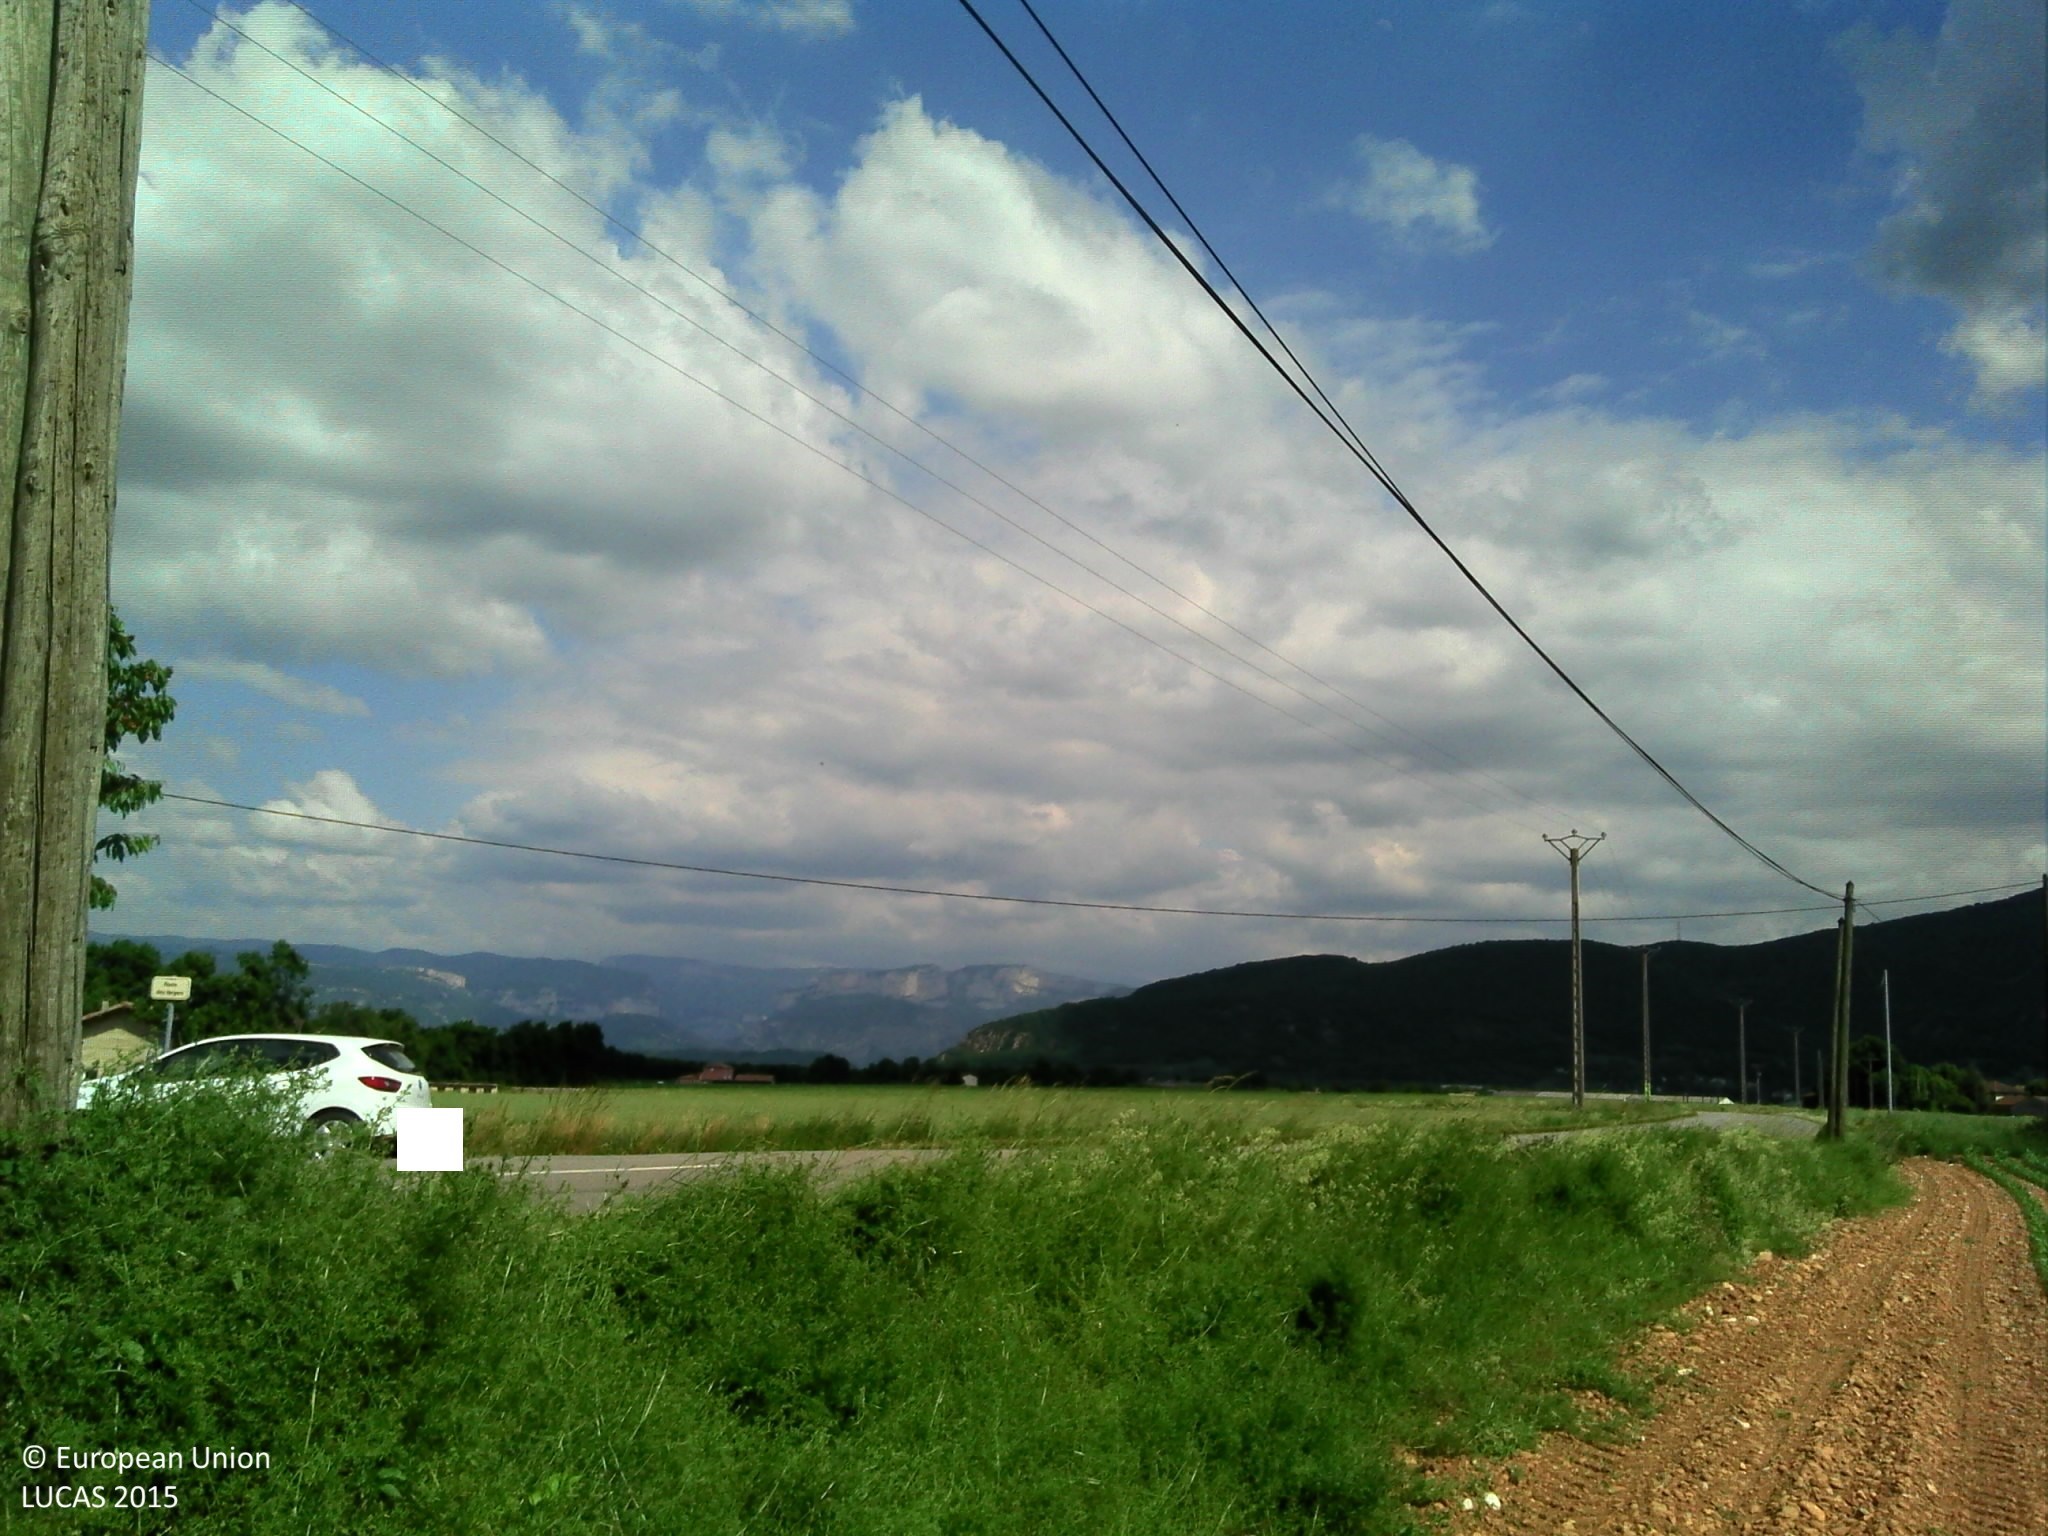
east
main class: Cropland
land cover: Maize
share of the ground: 10 - 25 %
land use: Agriculture (excluding fallow land and kitchen gardens)
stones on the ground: > 50 %
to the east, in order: Maize; Electric lines; Grass margins; Paved roads, cycling and walking lanes; Grass margins; Electric lines; Rye; Paved roads, cycling and walking lanes; Dry pulses
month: May
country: FR
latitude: 45.0699
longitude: 5.1917
